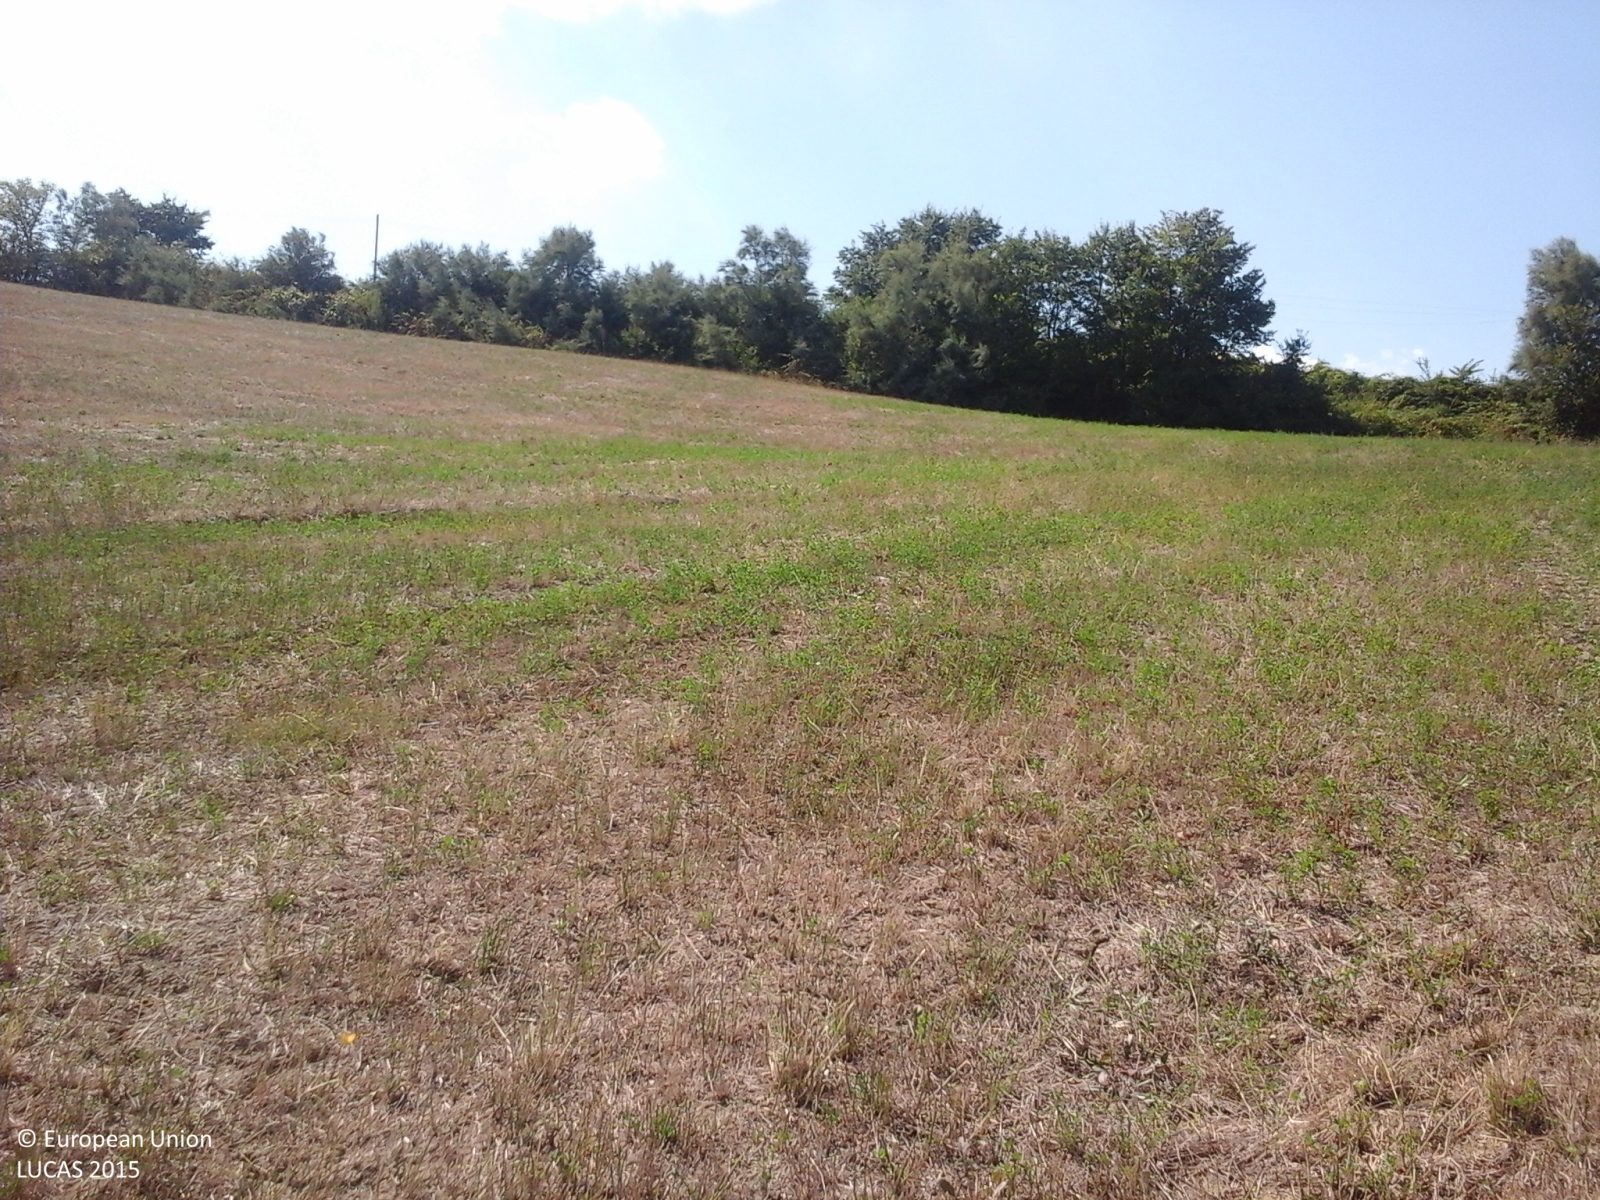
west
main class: Cropland
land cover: Lucerne
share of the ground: > 75 %
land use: Agriculture (excluding fallow land and kitchen gardens)
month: August
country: IT
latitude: 43.7749
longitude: 12.6647
